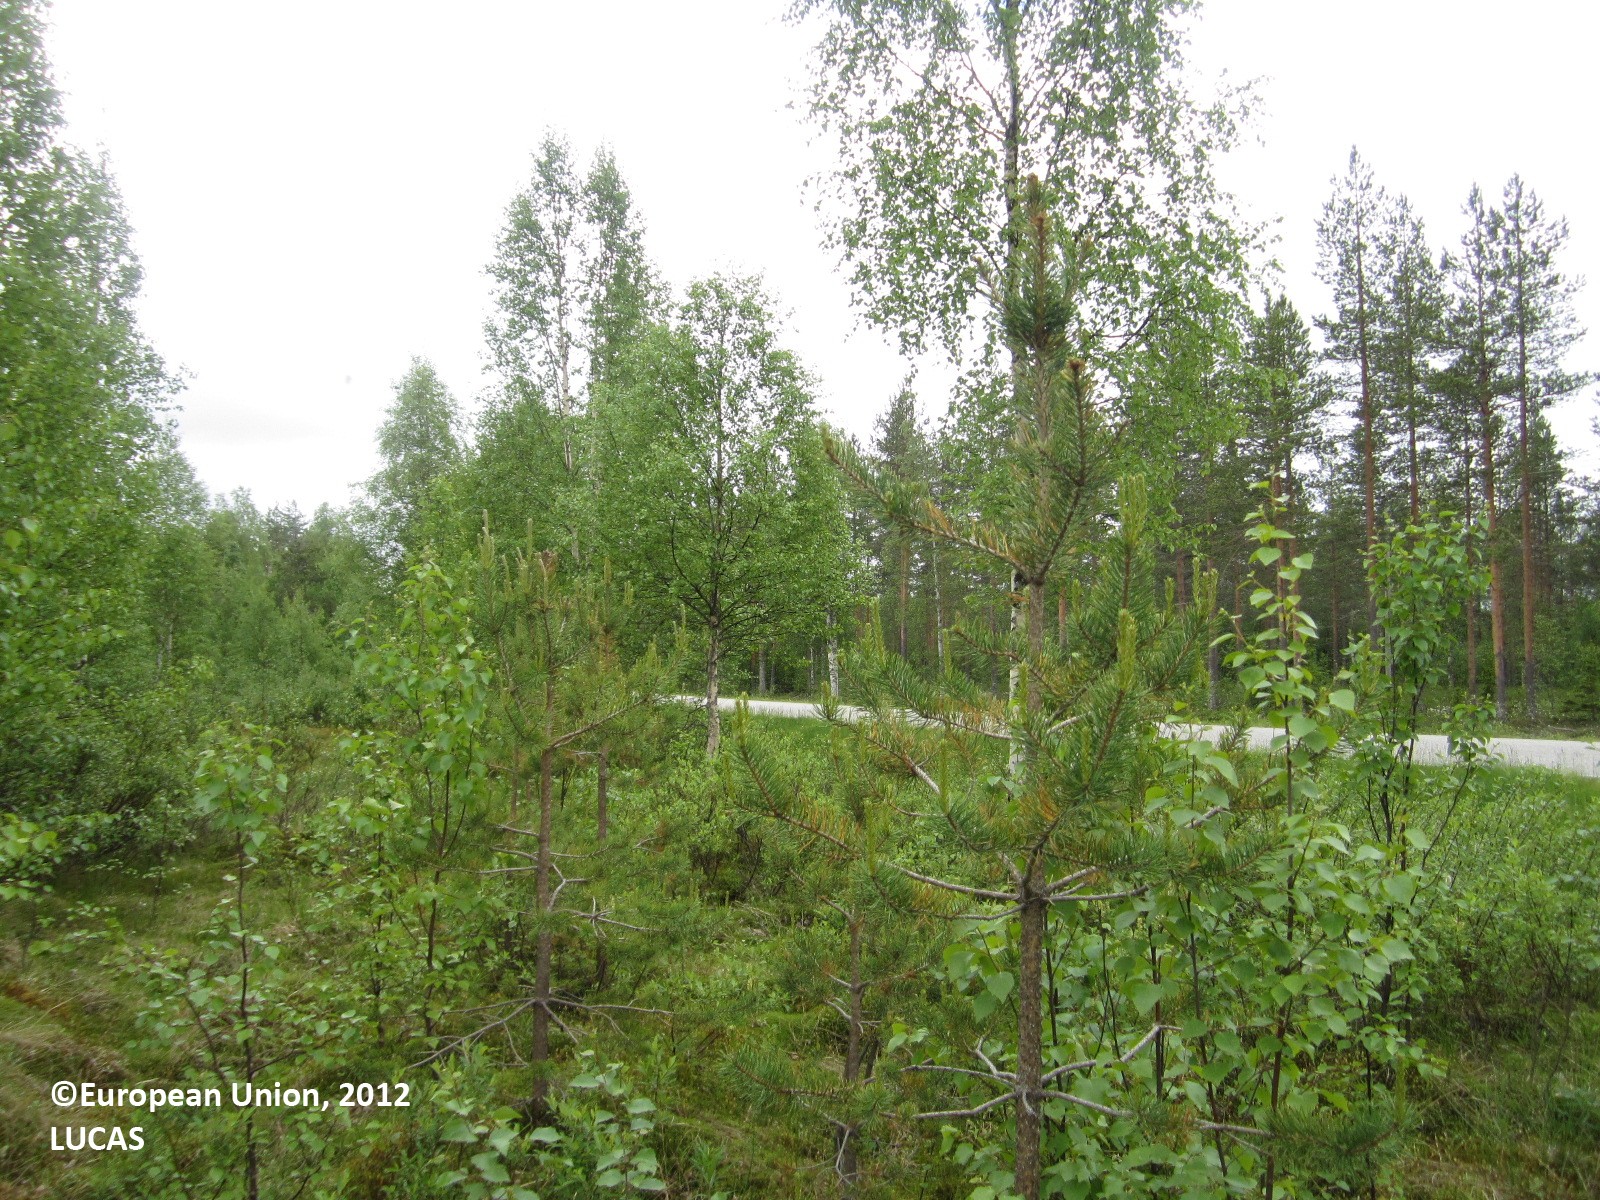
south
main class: Woodland
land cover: Broadleaved woodland
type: boreal forest
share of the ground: 50 - 75 %
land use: Forestry
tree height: > 5 m
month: June
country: FI
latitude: 64.7212
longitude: 29.6733
